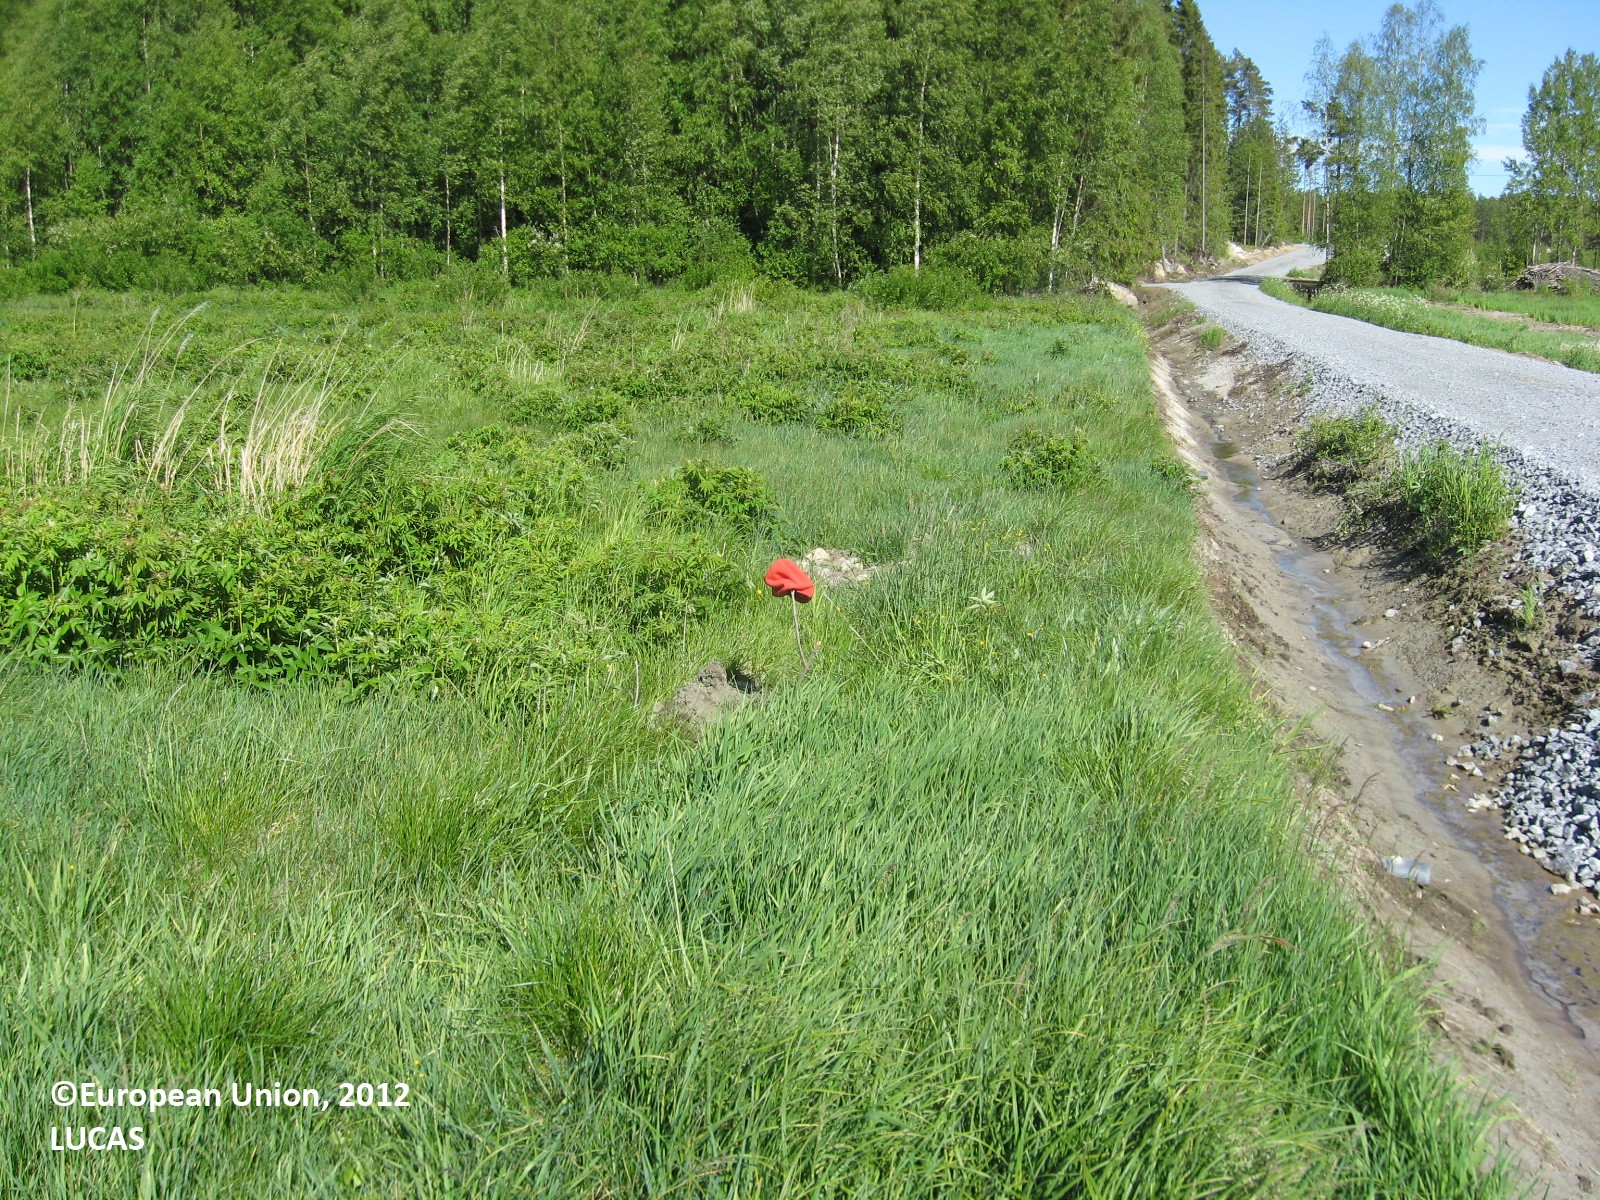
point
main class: Grassland
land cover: Grassland without tree/shrub cover
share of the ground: > 75 %
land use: Agriculture (excluding fallow land and kitchen gardens)
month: June
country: FI
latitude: 63.2942
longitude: 22.7573
